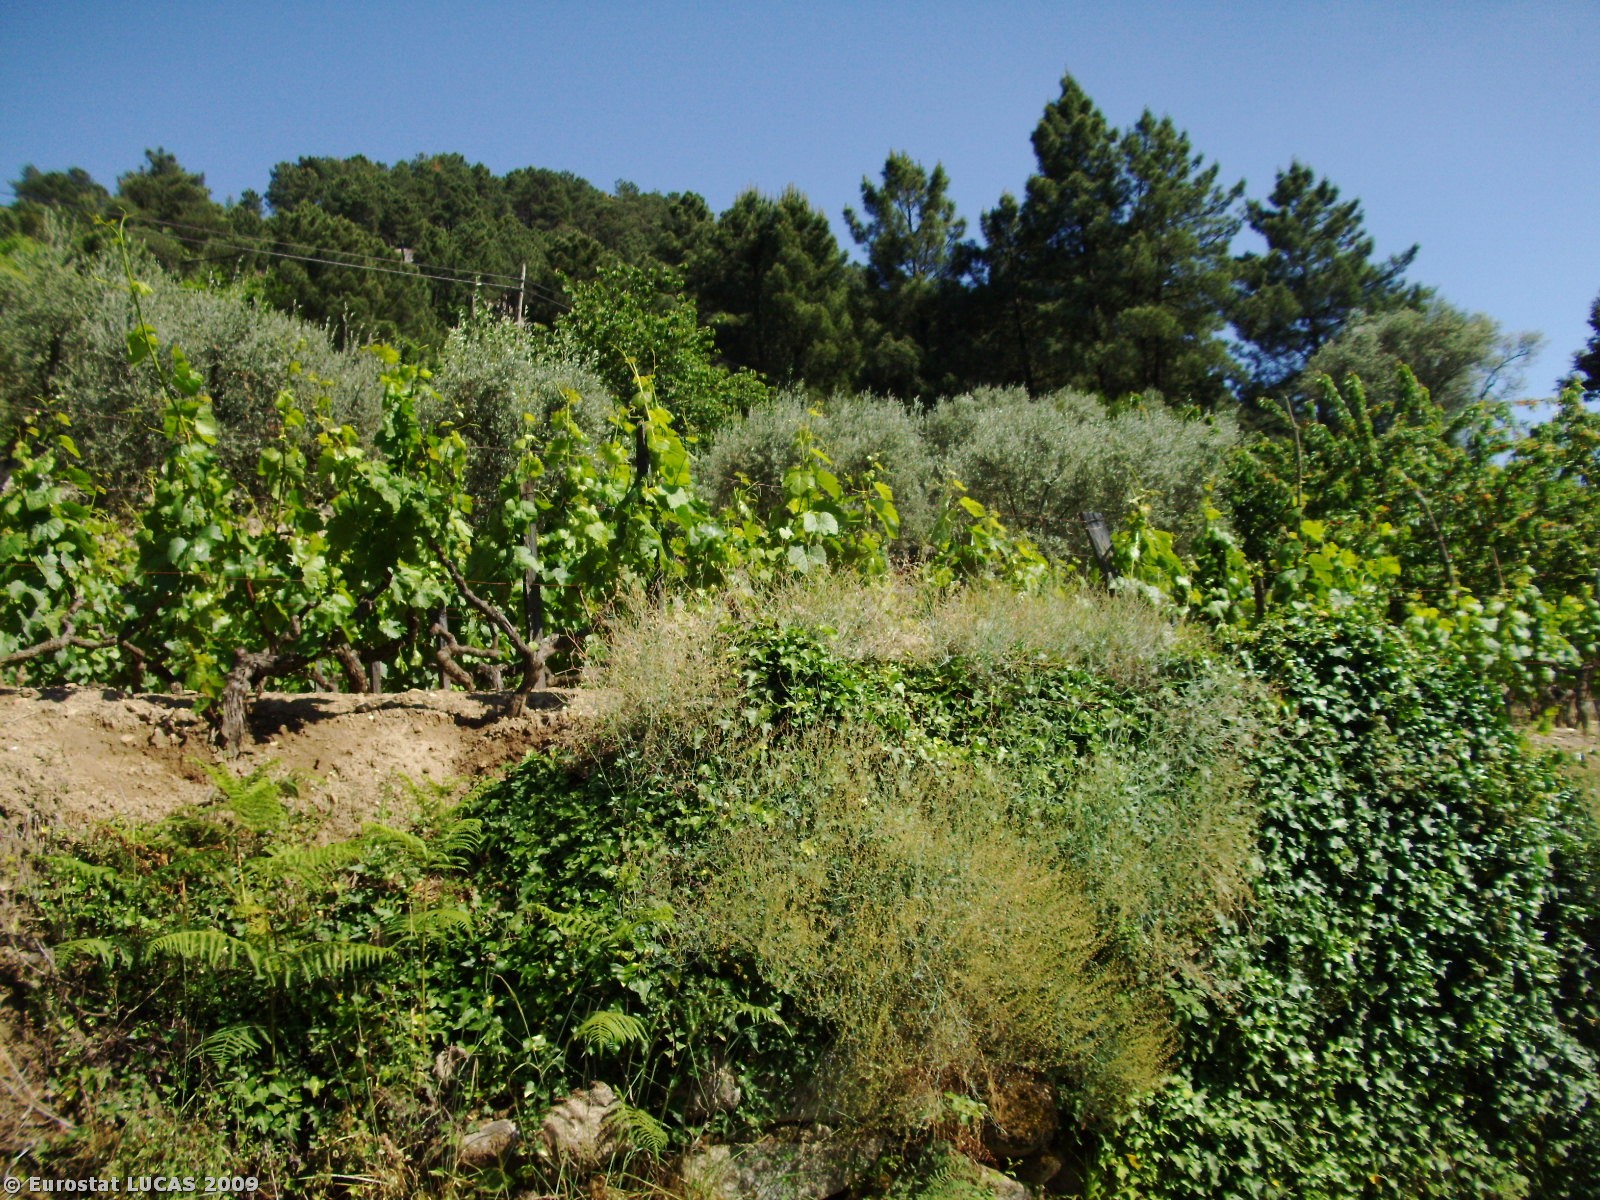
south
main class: Woodland
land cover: Coniferous woodland
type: coniferous forest of the mediterranean region
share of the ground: 25 - 50 %
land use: Forestry
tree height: > 5 m
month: May
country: PT
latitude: 41.0961
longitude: -7.6134
